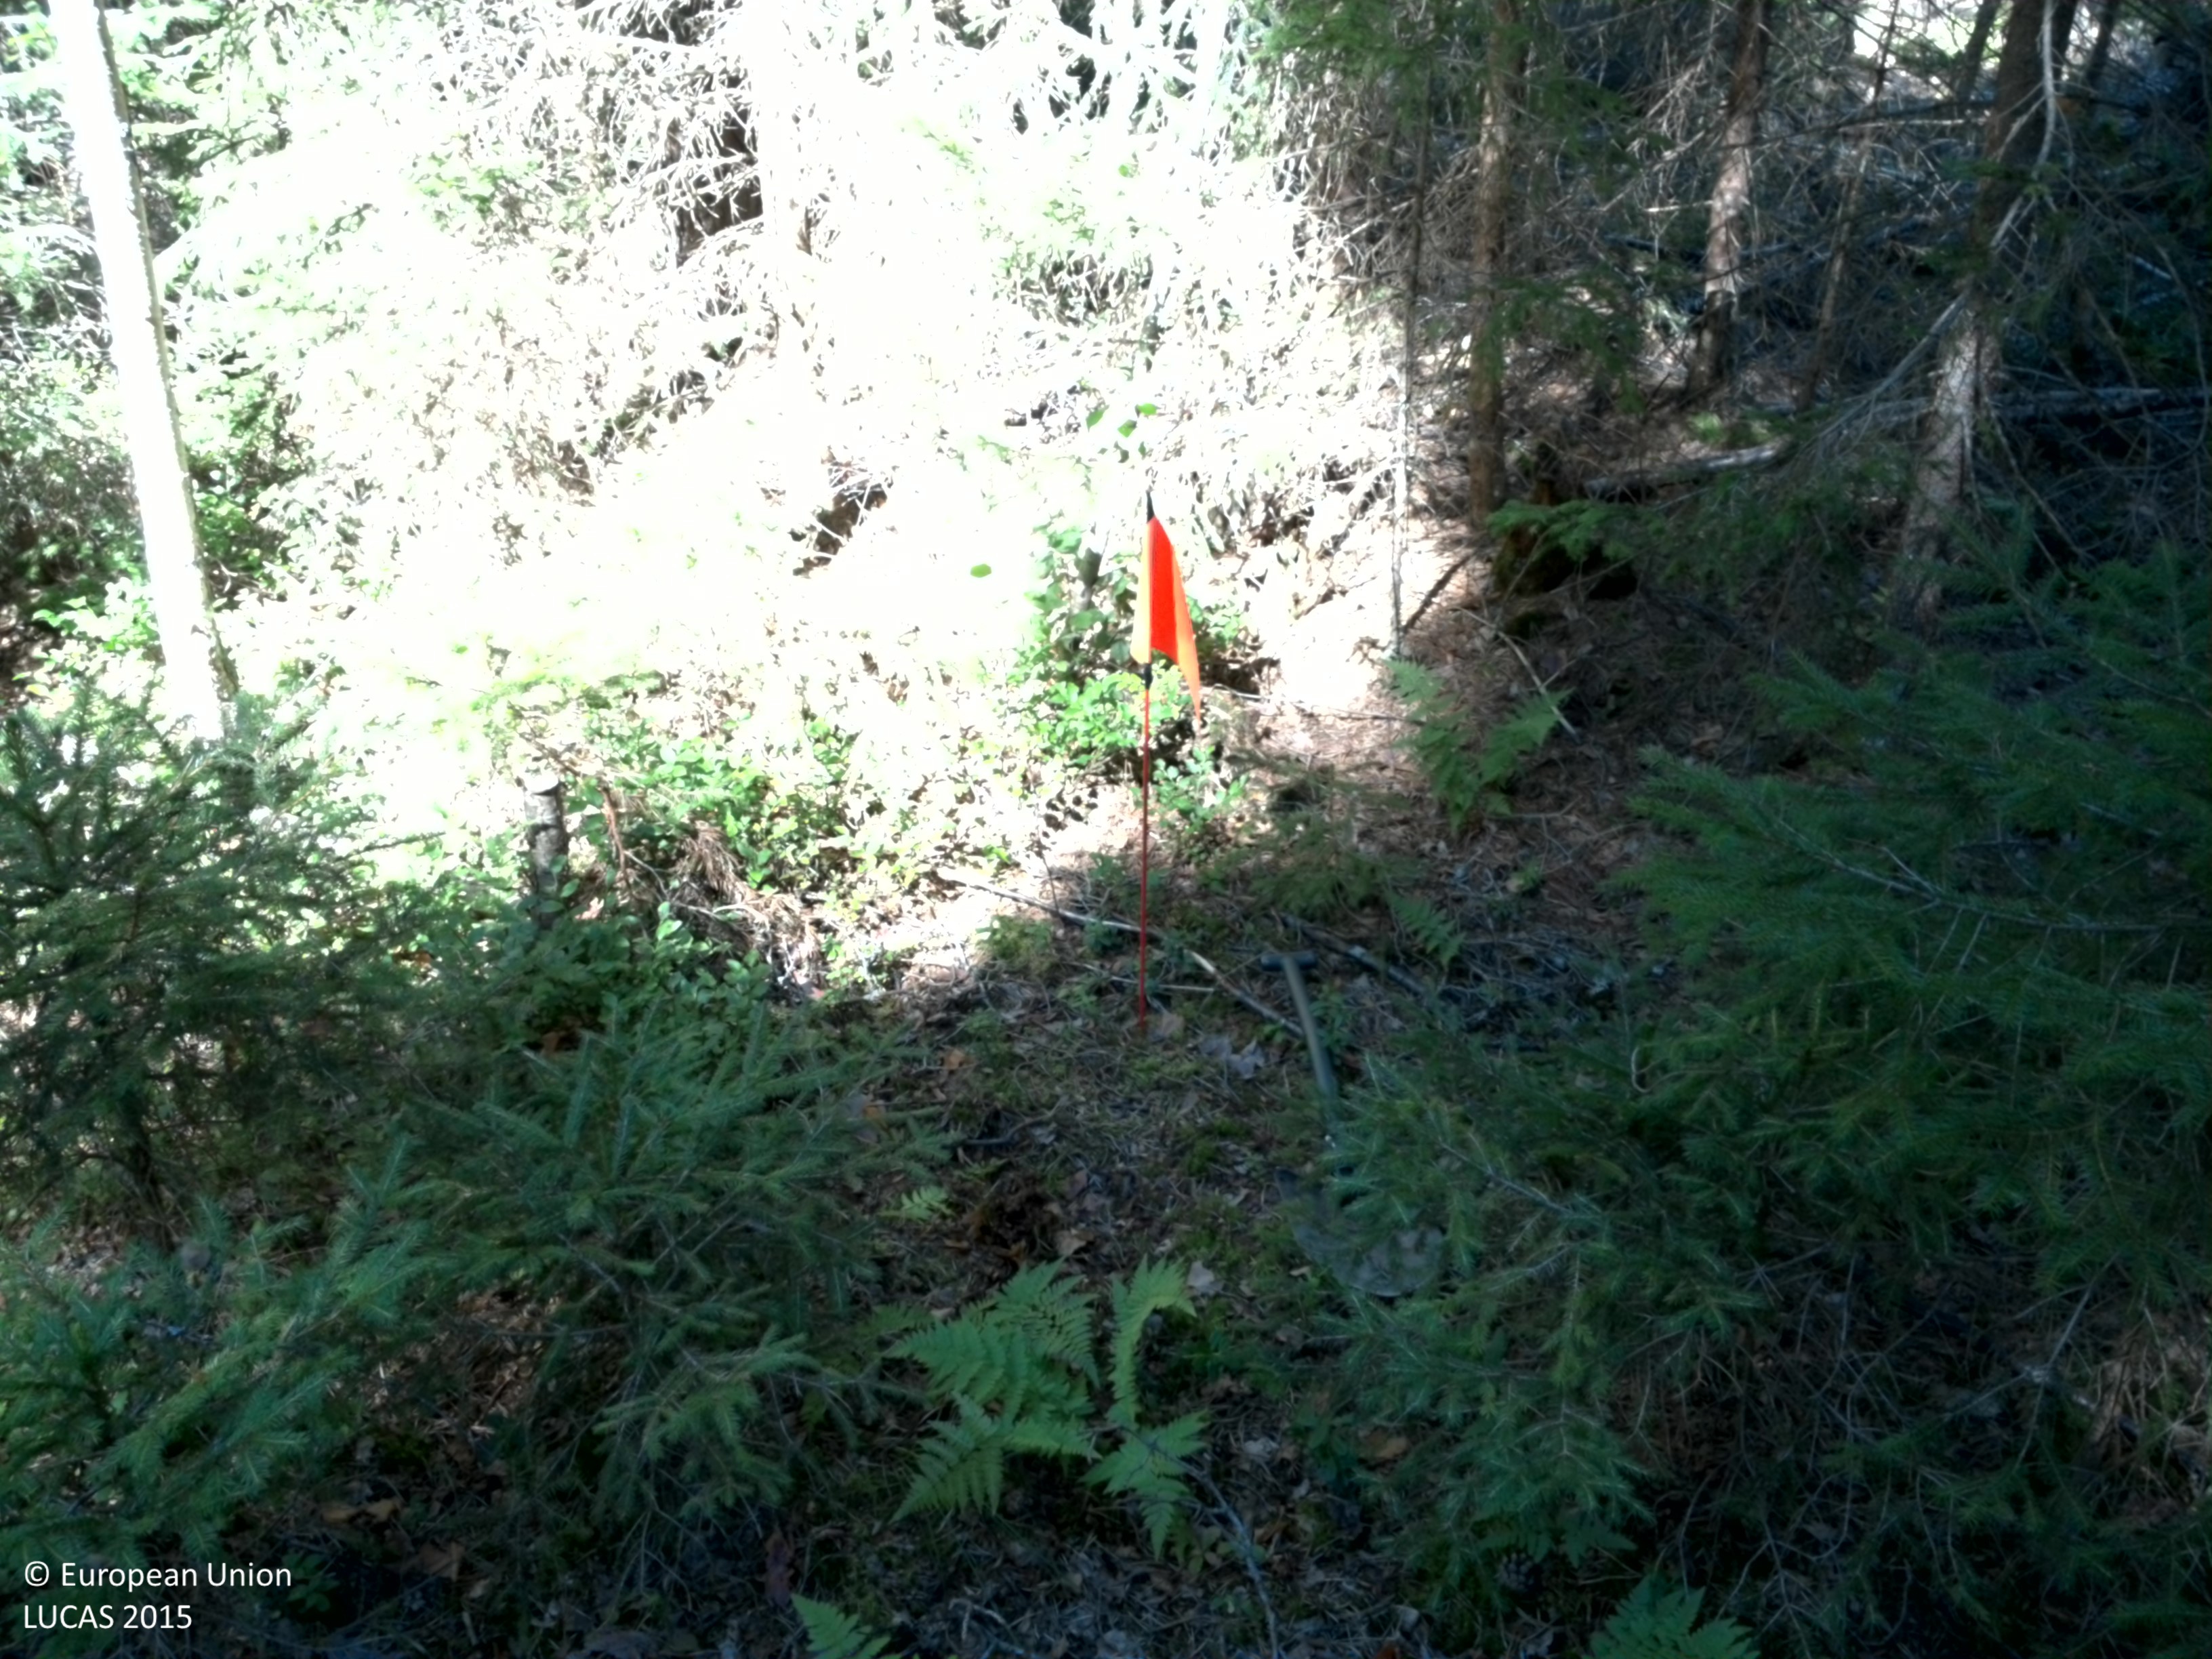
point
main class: Woodland
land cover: Other coniferous woodland
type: boreal forest
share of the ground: > 75 %
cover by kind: coniferous forest trees 85 %, broadleaved forest trees 10 %, herbaceous plants 5 %
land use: Forestry
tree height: > 5 m
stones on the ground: > 50 %
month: August
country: SE
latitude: 60.0943
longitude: 17.0581
